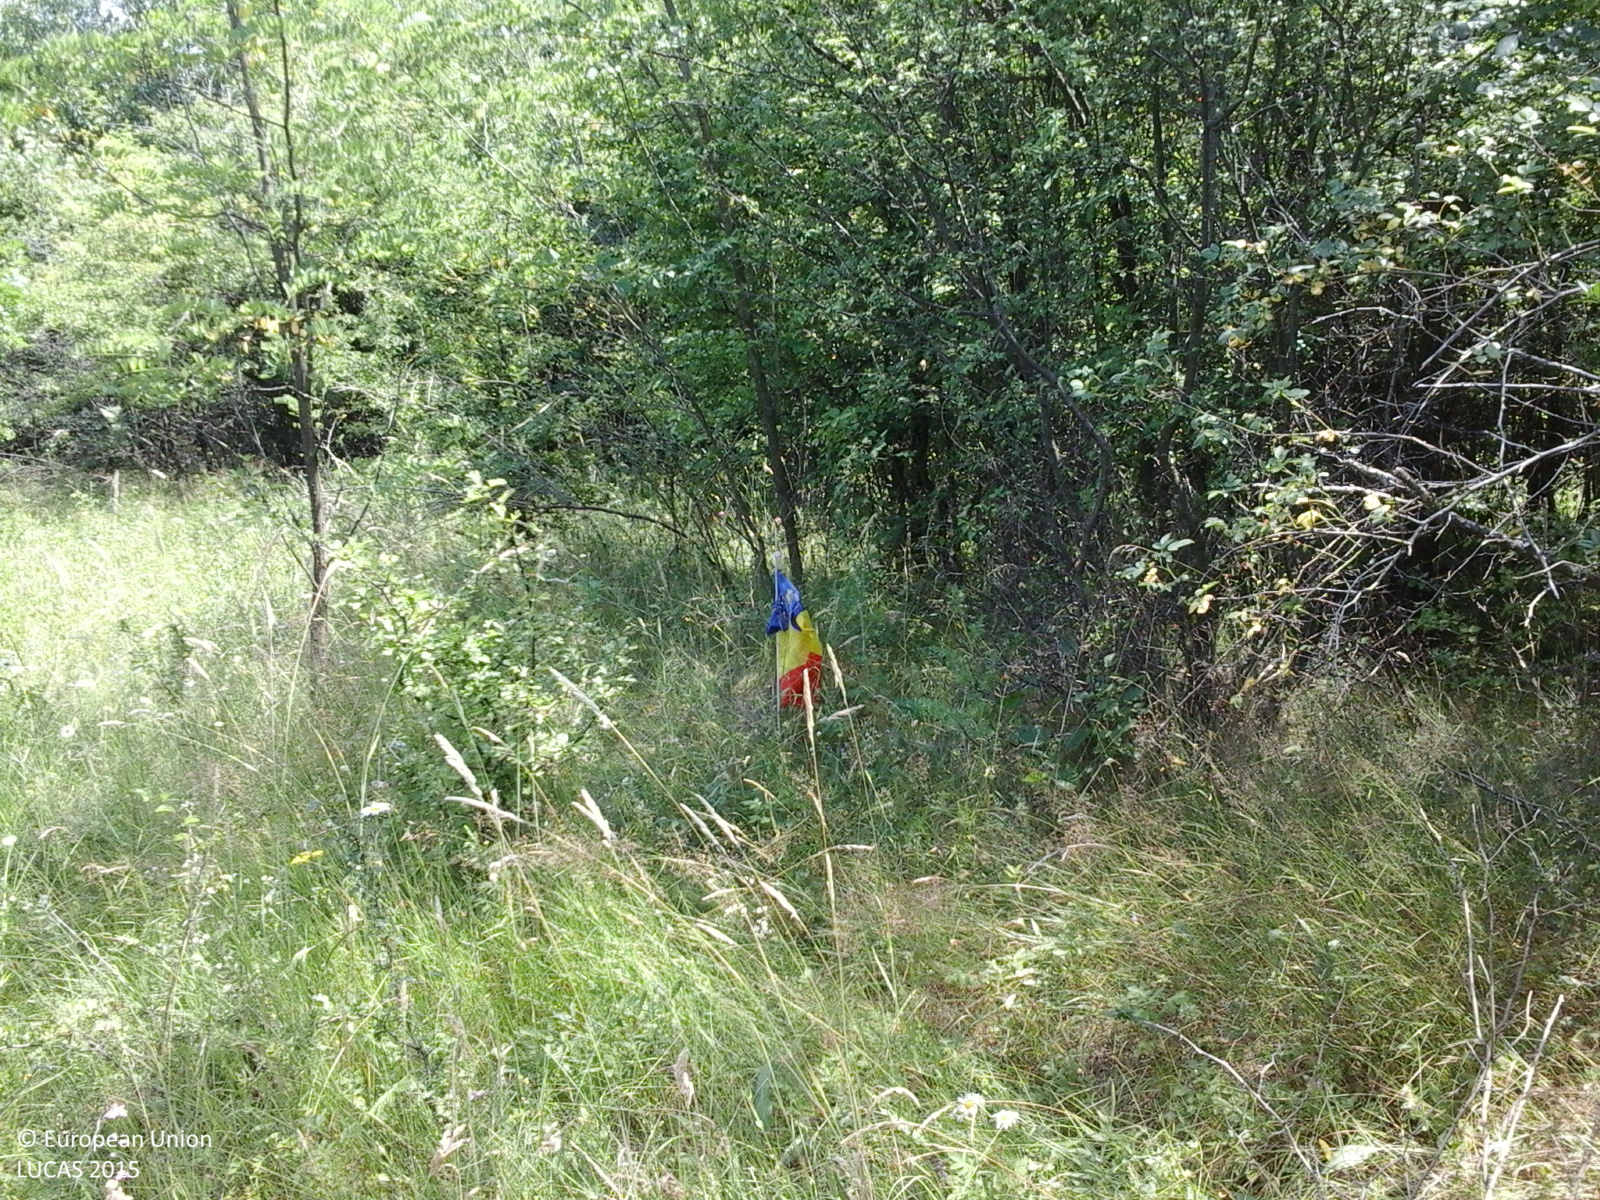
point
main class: Woodland
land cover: Broadleaved woodland
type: acidophilous oak and oak-birch forest
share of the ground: > 75 %
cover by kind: broadleaved forest trees 100 %
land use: Forestry
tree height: > 5 m
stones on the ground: < 10 %
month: July
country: RO
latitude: 44.7622
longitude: 24.5655
